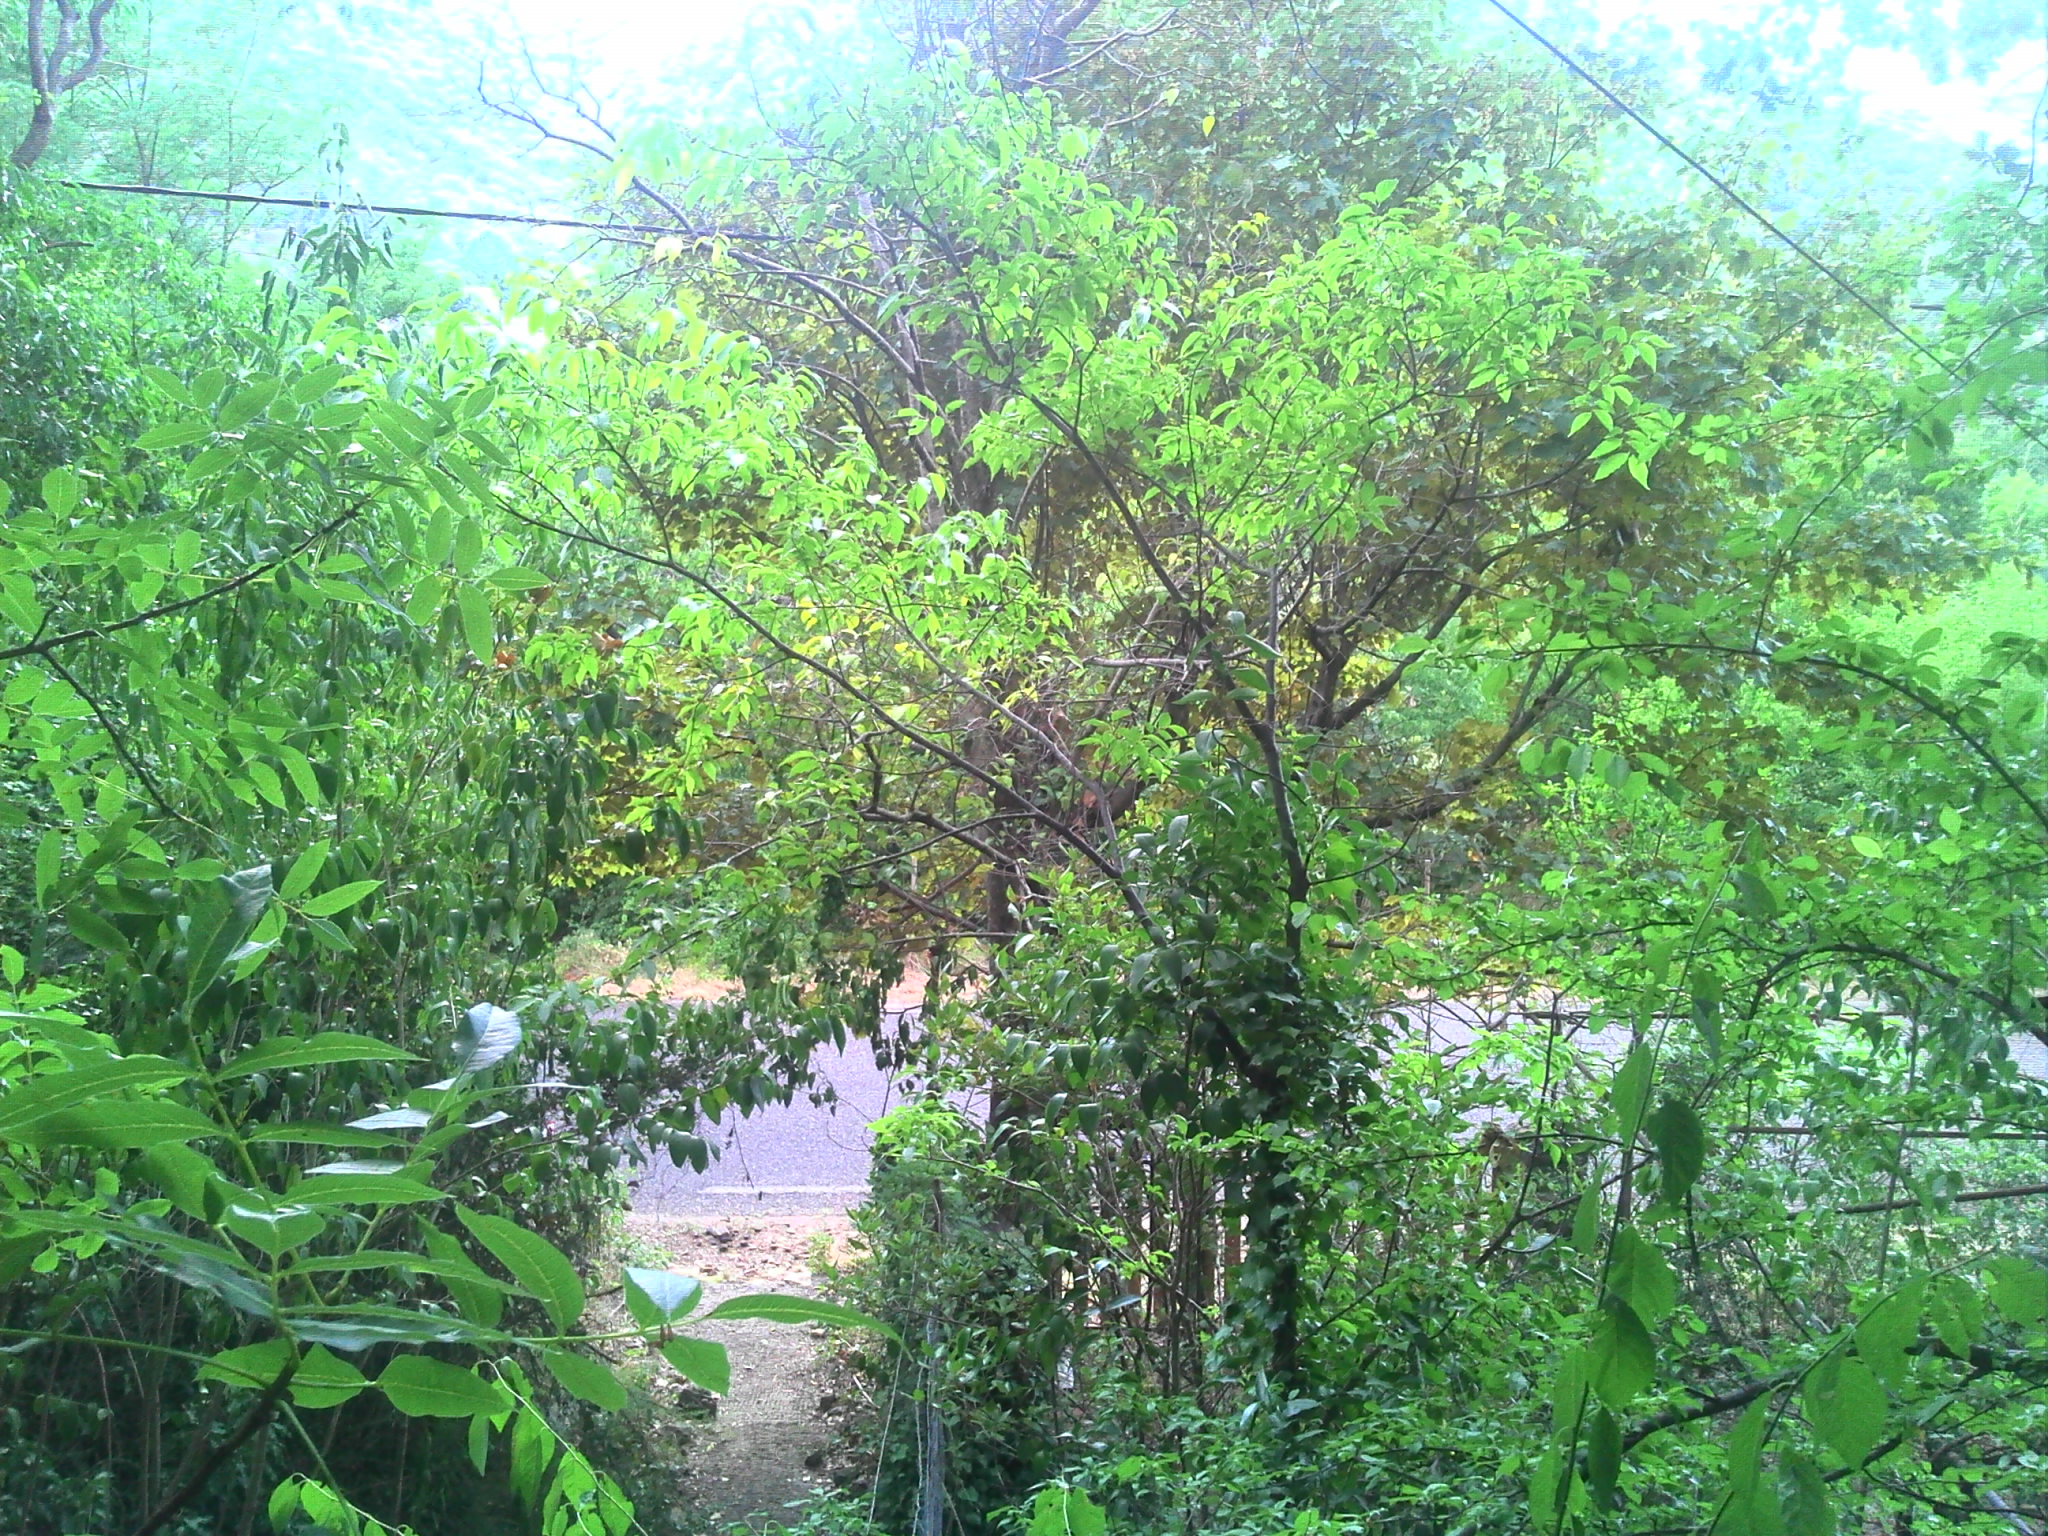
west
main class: Woodland
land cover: Broadleaved woodland
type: mesophytic deciduous forest
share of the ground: > 75 %
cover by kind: broadleaved forest trees 80 %, herbaceous plants 10 %, consolidated bare surface 10 %
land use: Forestry
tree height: > 5 m
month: July
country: FR
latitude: 44.1016
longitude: 3.9487
